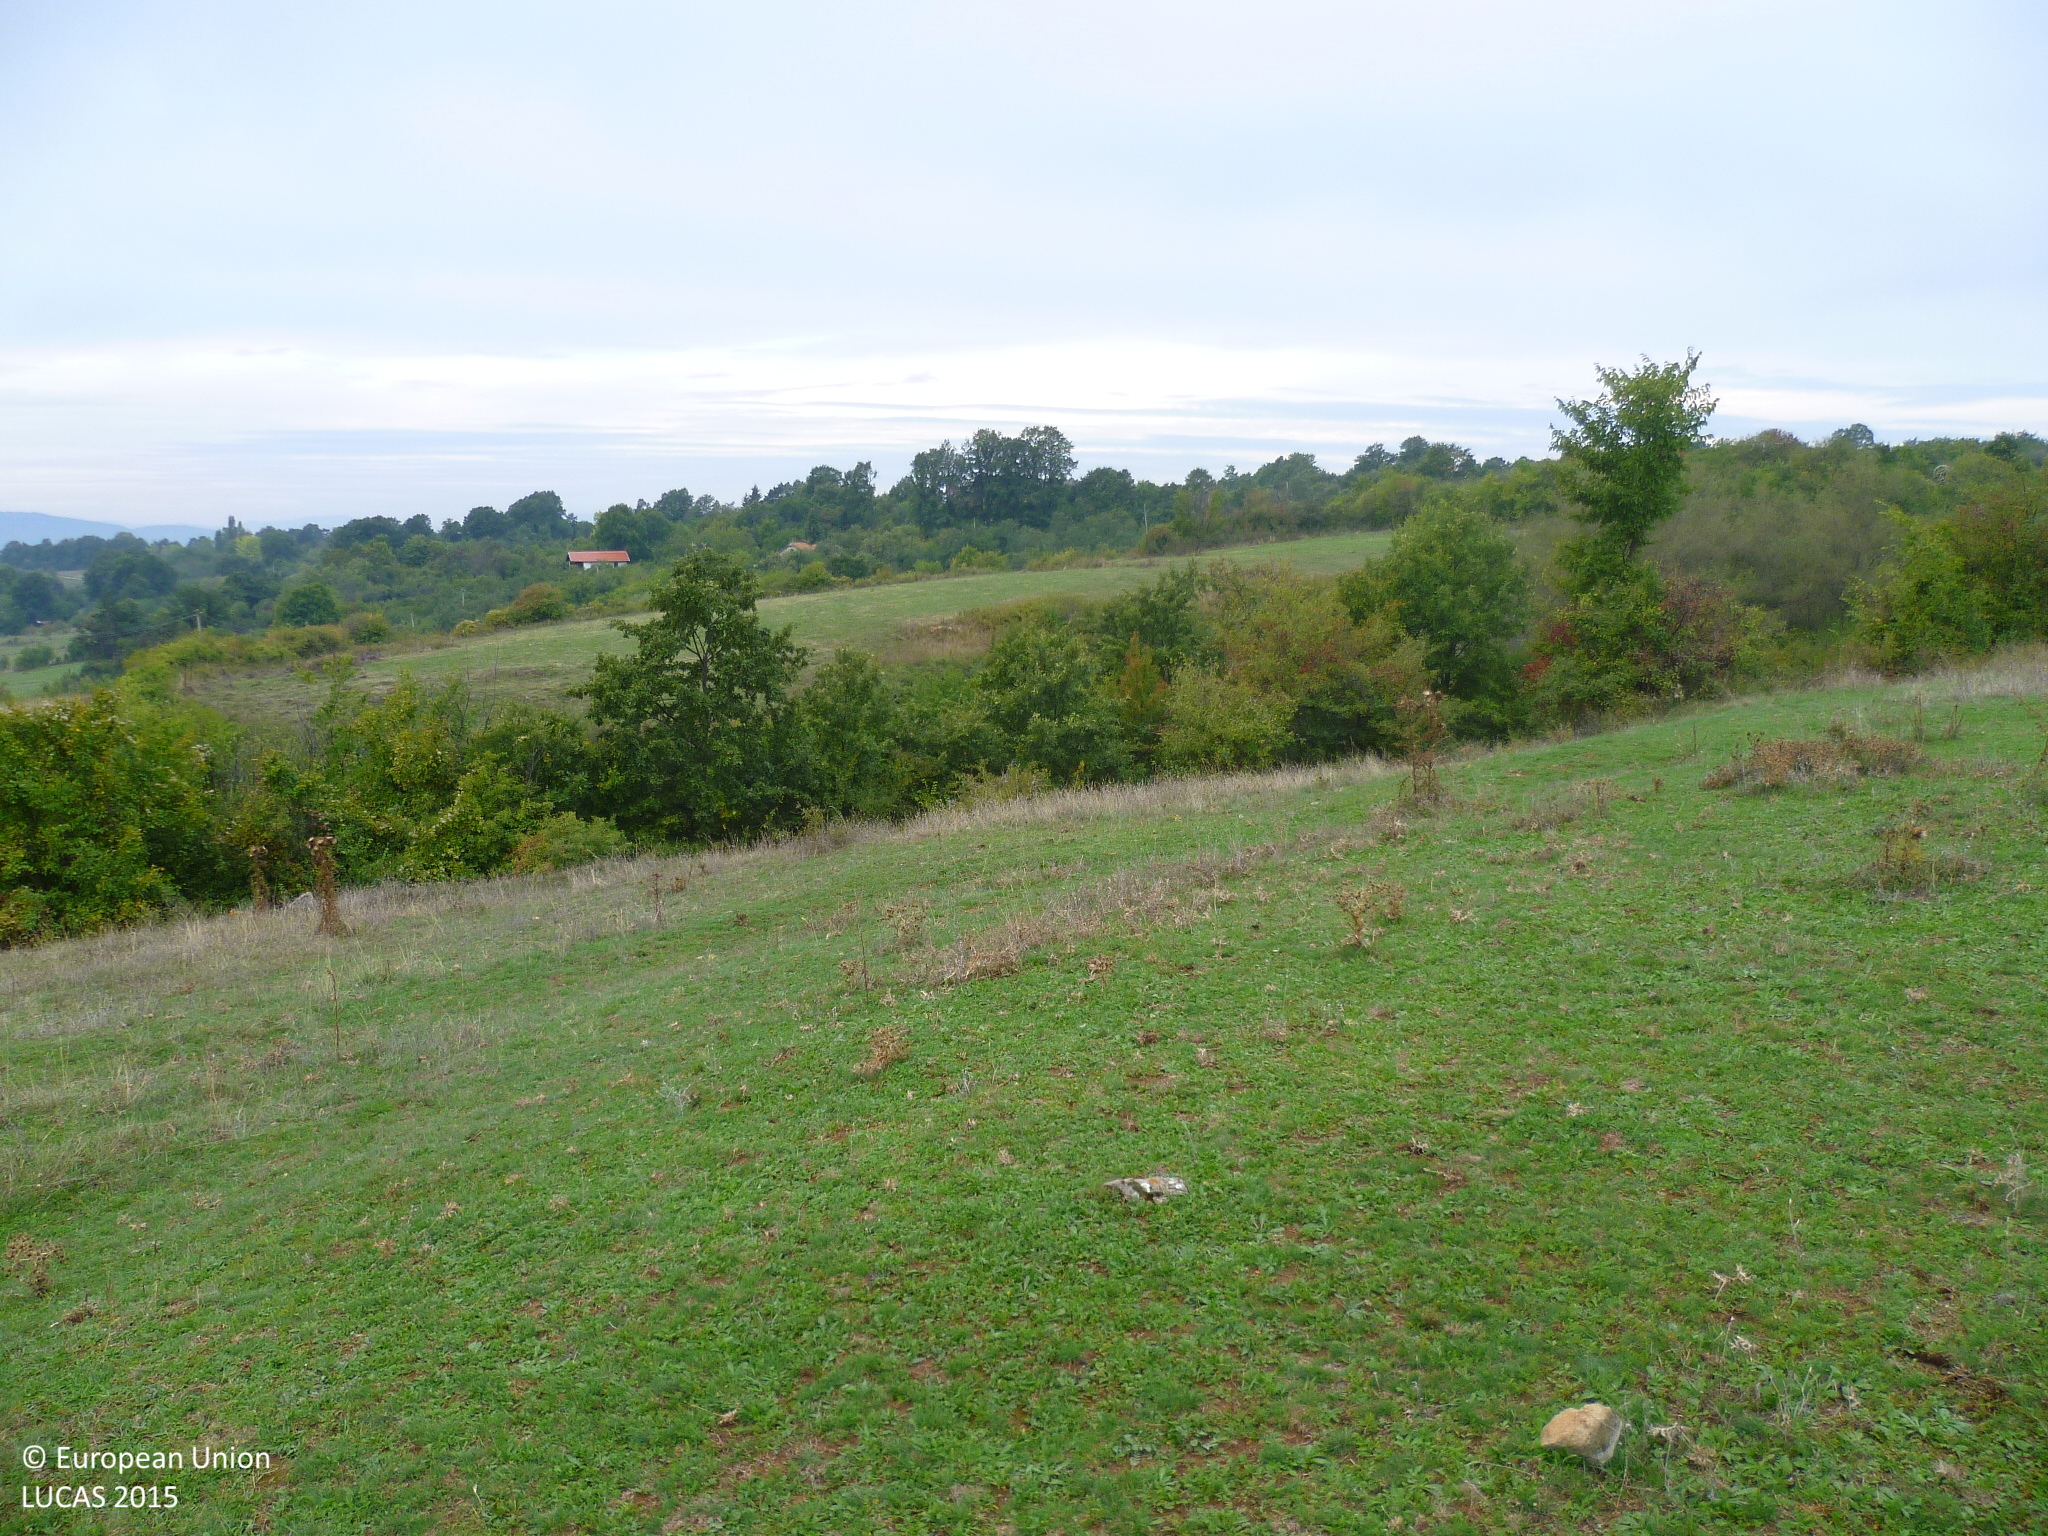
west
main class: Grassland
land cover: Grassland without tree/shrub cover
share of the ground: > 75 %
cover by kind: herbaceous plants 100 %
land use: Agriculture (excluding fallow land and kitchen gardens)
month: October
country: BG
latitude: 43.0143
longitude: 23.0266
